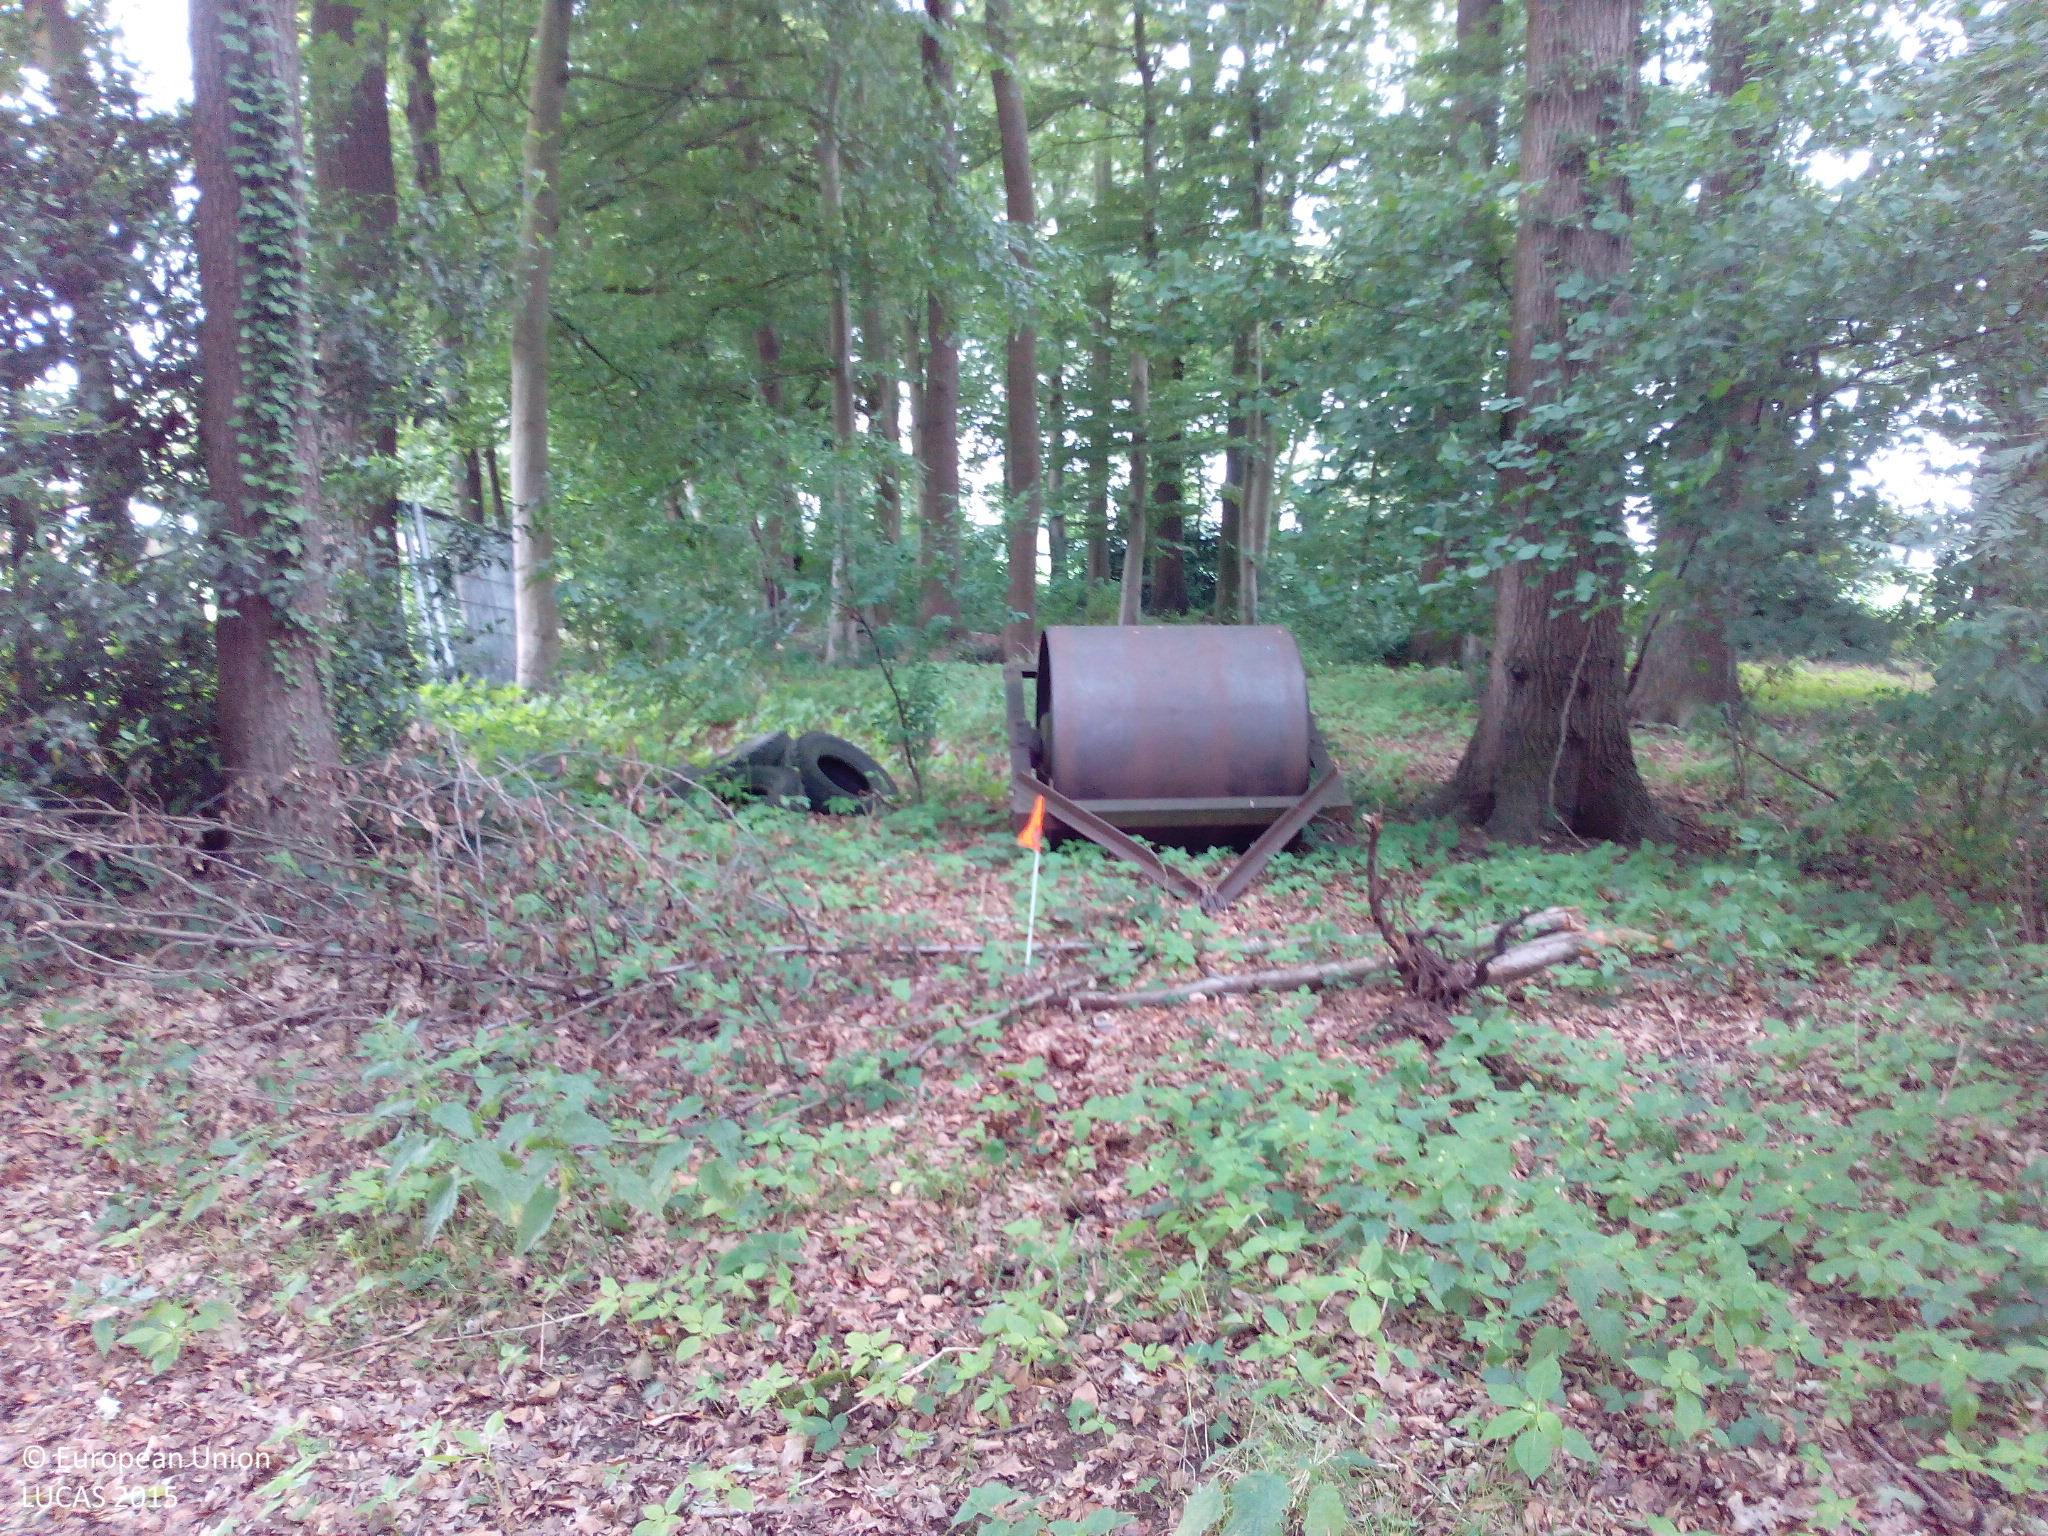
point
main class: Woodland
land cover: Broadleaved woodland
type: mesophytic deciduous forest
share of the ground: > 75 %
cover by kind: broadleaved forest trees 100 %
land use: Agriculture (excluding fallow land and kitchen gardens)
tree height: > 5 m
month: July
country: DE
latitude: 51.8295
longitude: 8.5638
